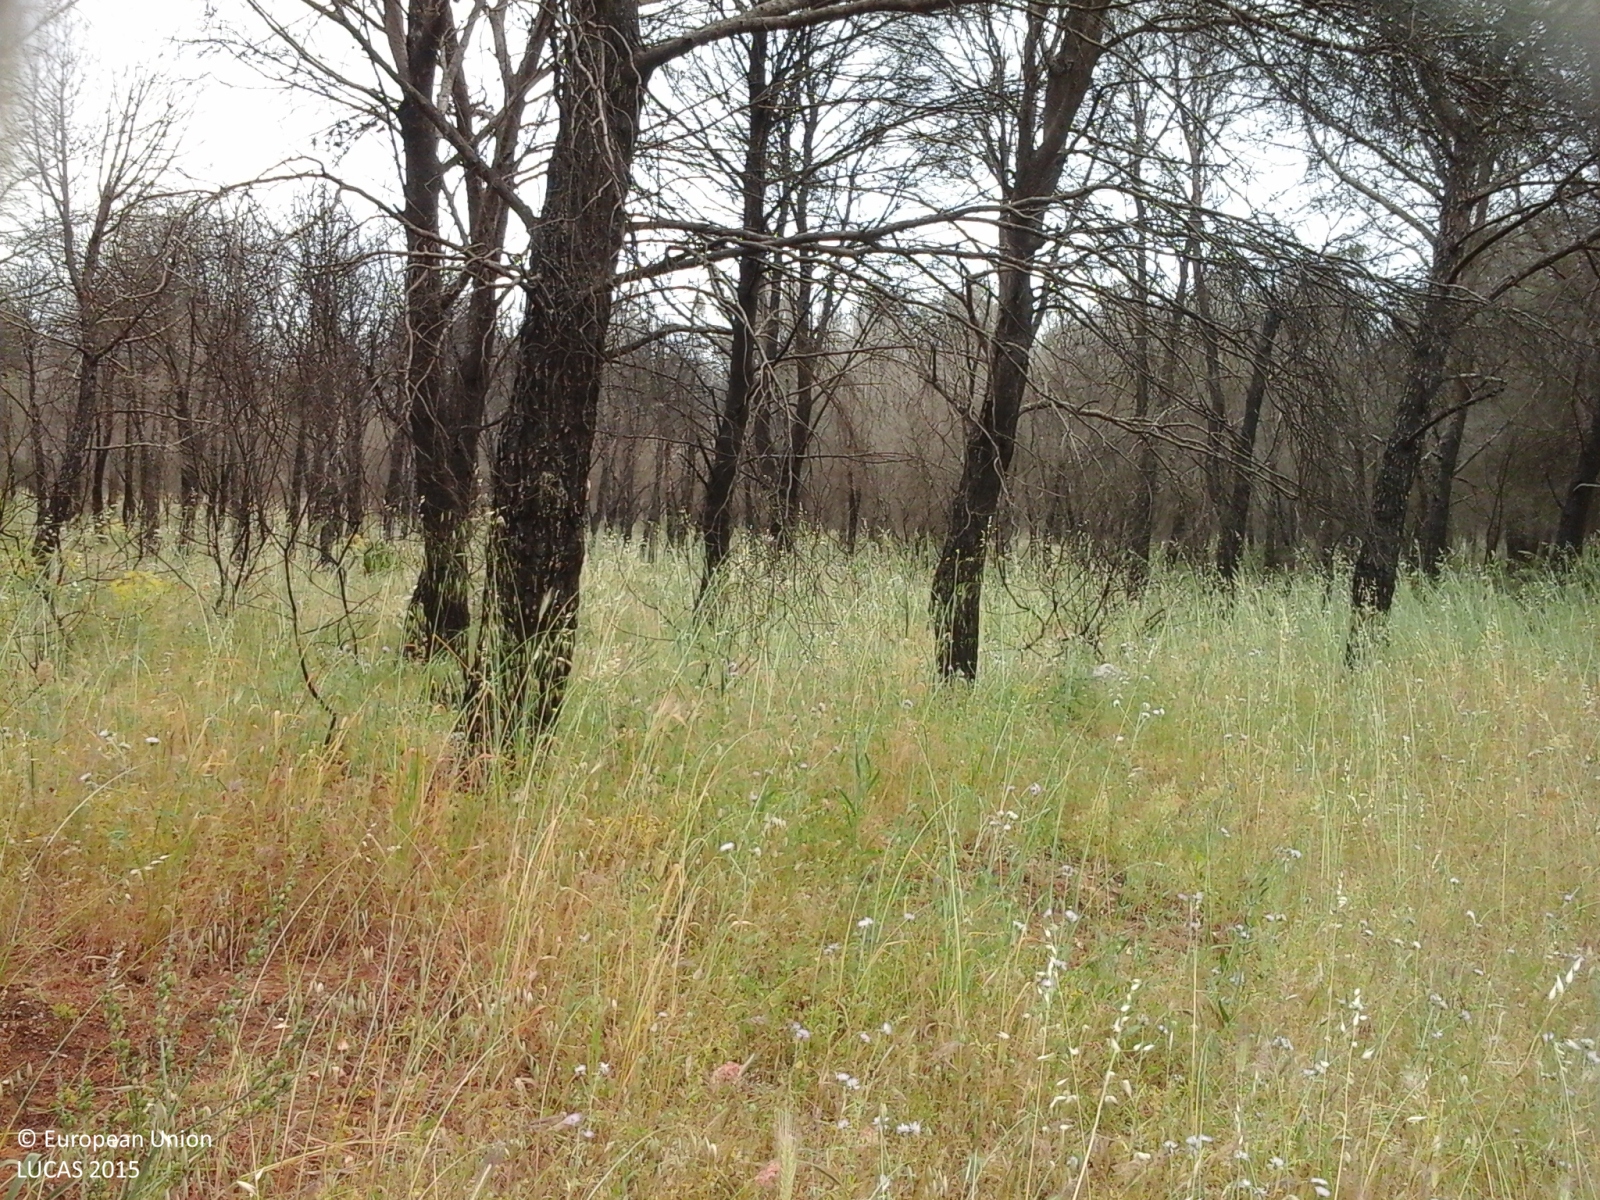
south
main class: Woodland
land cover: Pine dominated mixed woodland
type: coniferous forest of the mediterranean region
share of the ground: > 75 %
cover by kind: coniferous forest trees 65 %, broadleaved forest trees 25 %, shrubs 5 %, herbaceous plants 5 %
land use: Forestry
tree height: > 5 m
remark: Burnt area
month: May
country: IT
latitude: 37.6645
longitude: 12.9817
